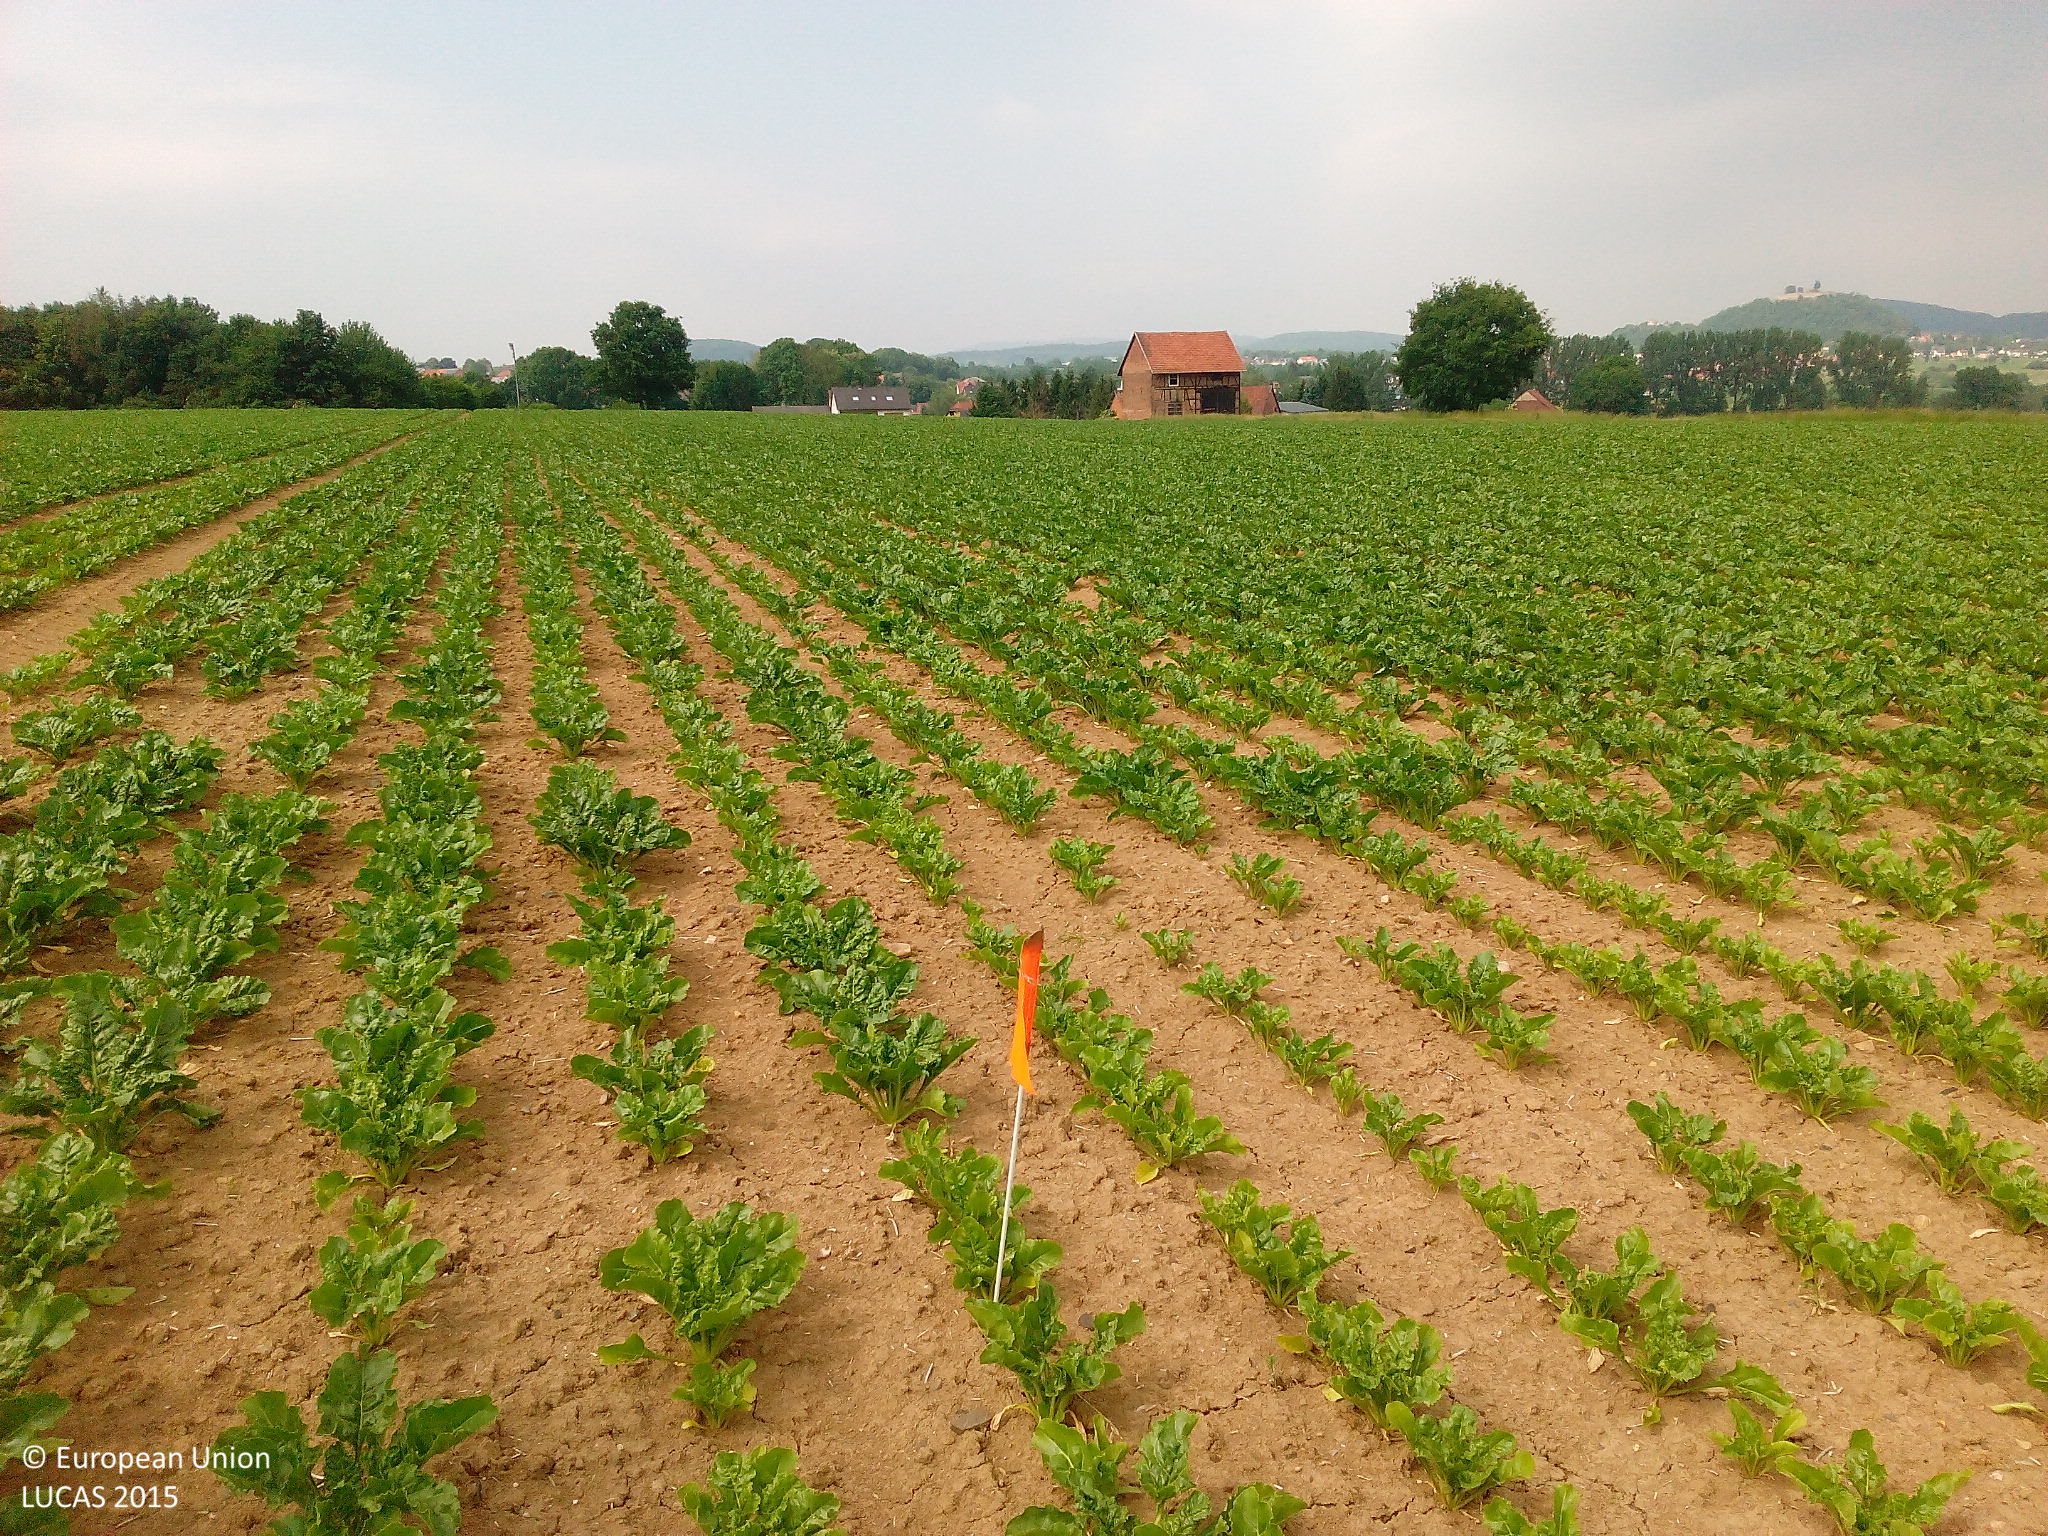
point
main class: Cropland
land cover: Sugar beet
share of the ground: 25 - 50 %
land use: Agriculture (excluding fallow land and kitchen gardens)
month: June
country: DE
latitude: 51.1534
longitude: 9.3568
